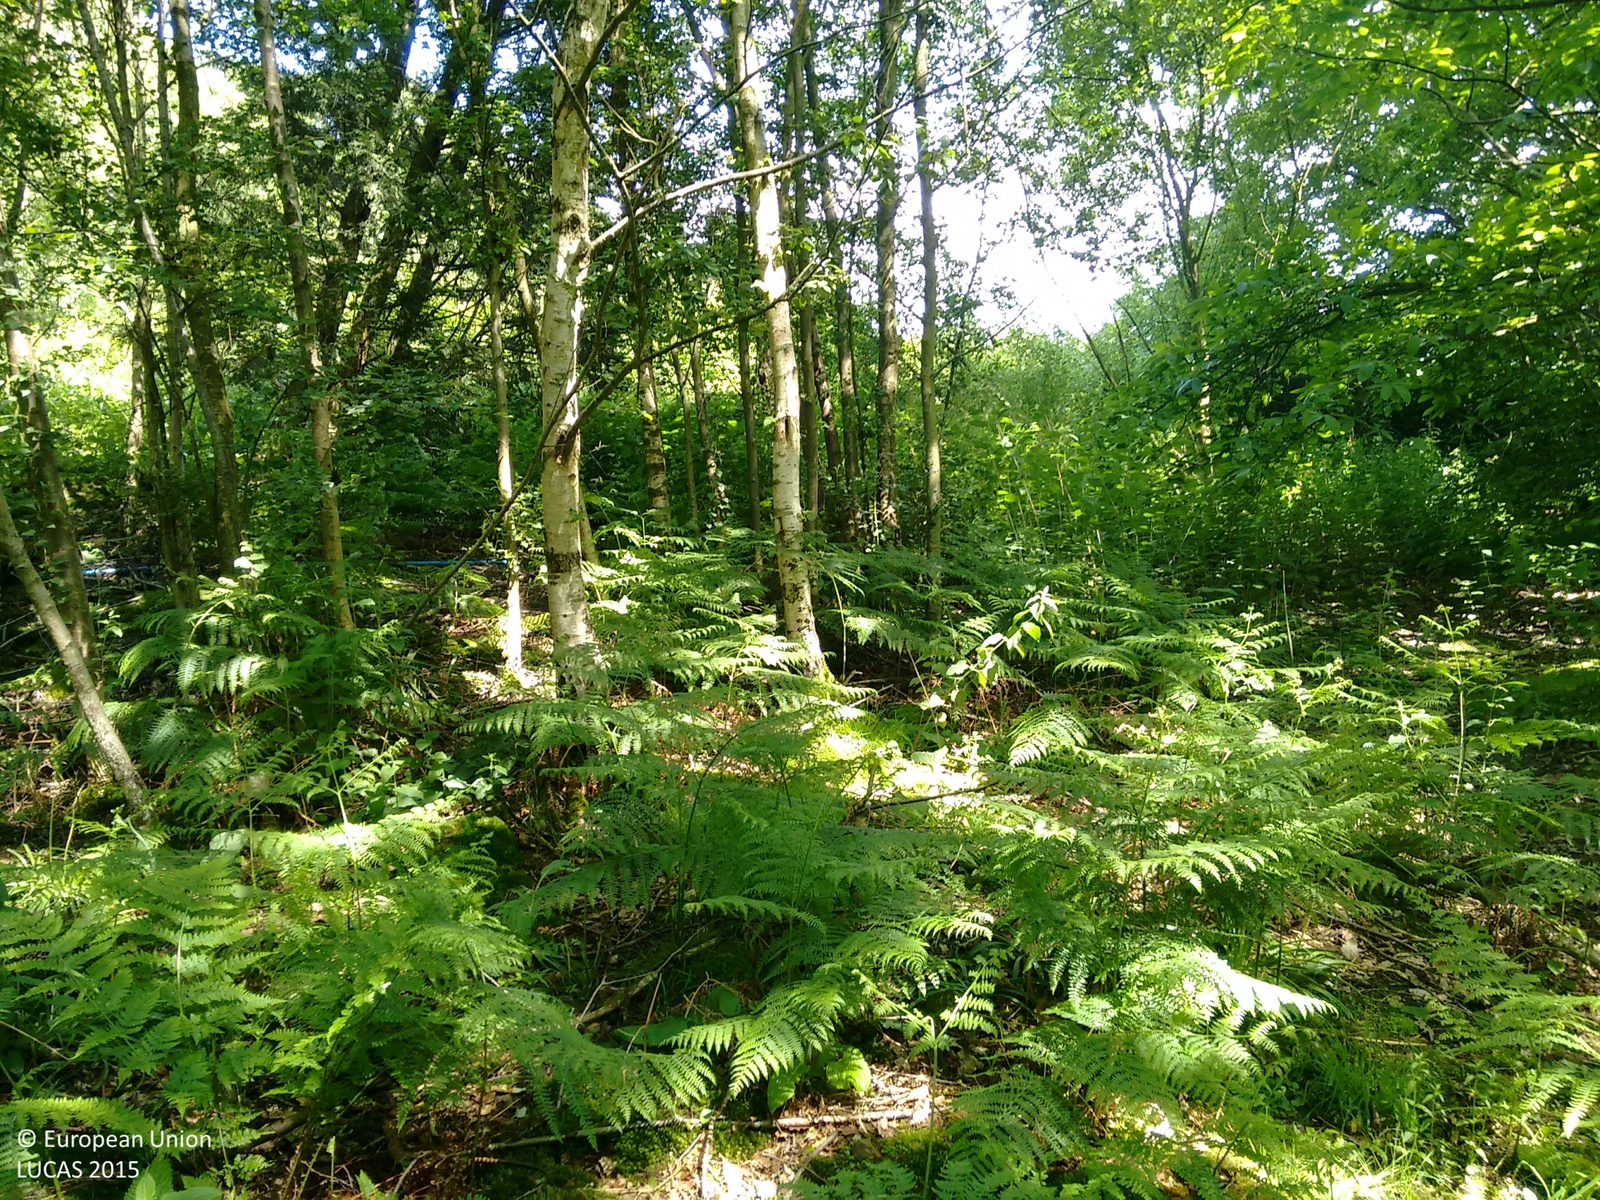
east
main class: Woodland
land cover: Broadleaved woodland
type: mesophytic deciduous forest
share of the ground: > 75 %
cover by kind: broadleaved forest trees 75 %, coniferous forest trees 15 %, shrubs 5 %, herbaceous plants 5 %
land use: Forestry
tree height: > 5 m
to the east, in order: Broadleaved woodland; Managed hedges; Tracks; Managed hedges; Grassland without tree/shrub cover; Vineyards; Spontaneously vegetated surfaces
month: June
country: GB
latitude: 51.0445
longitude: 0.6021
